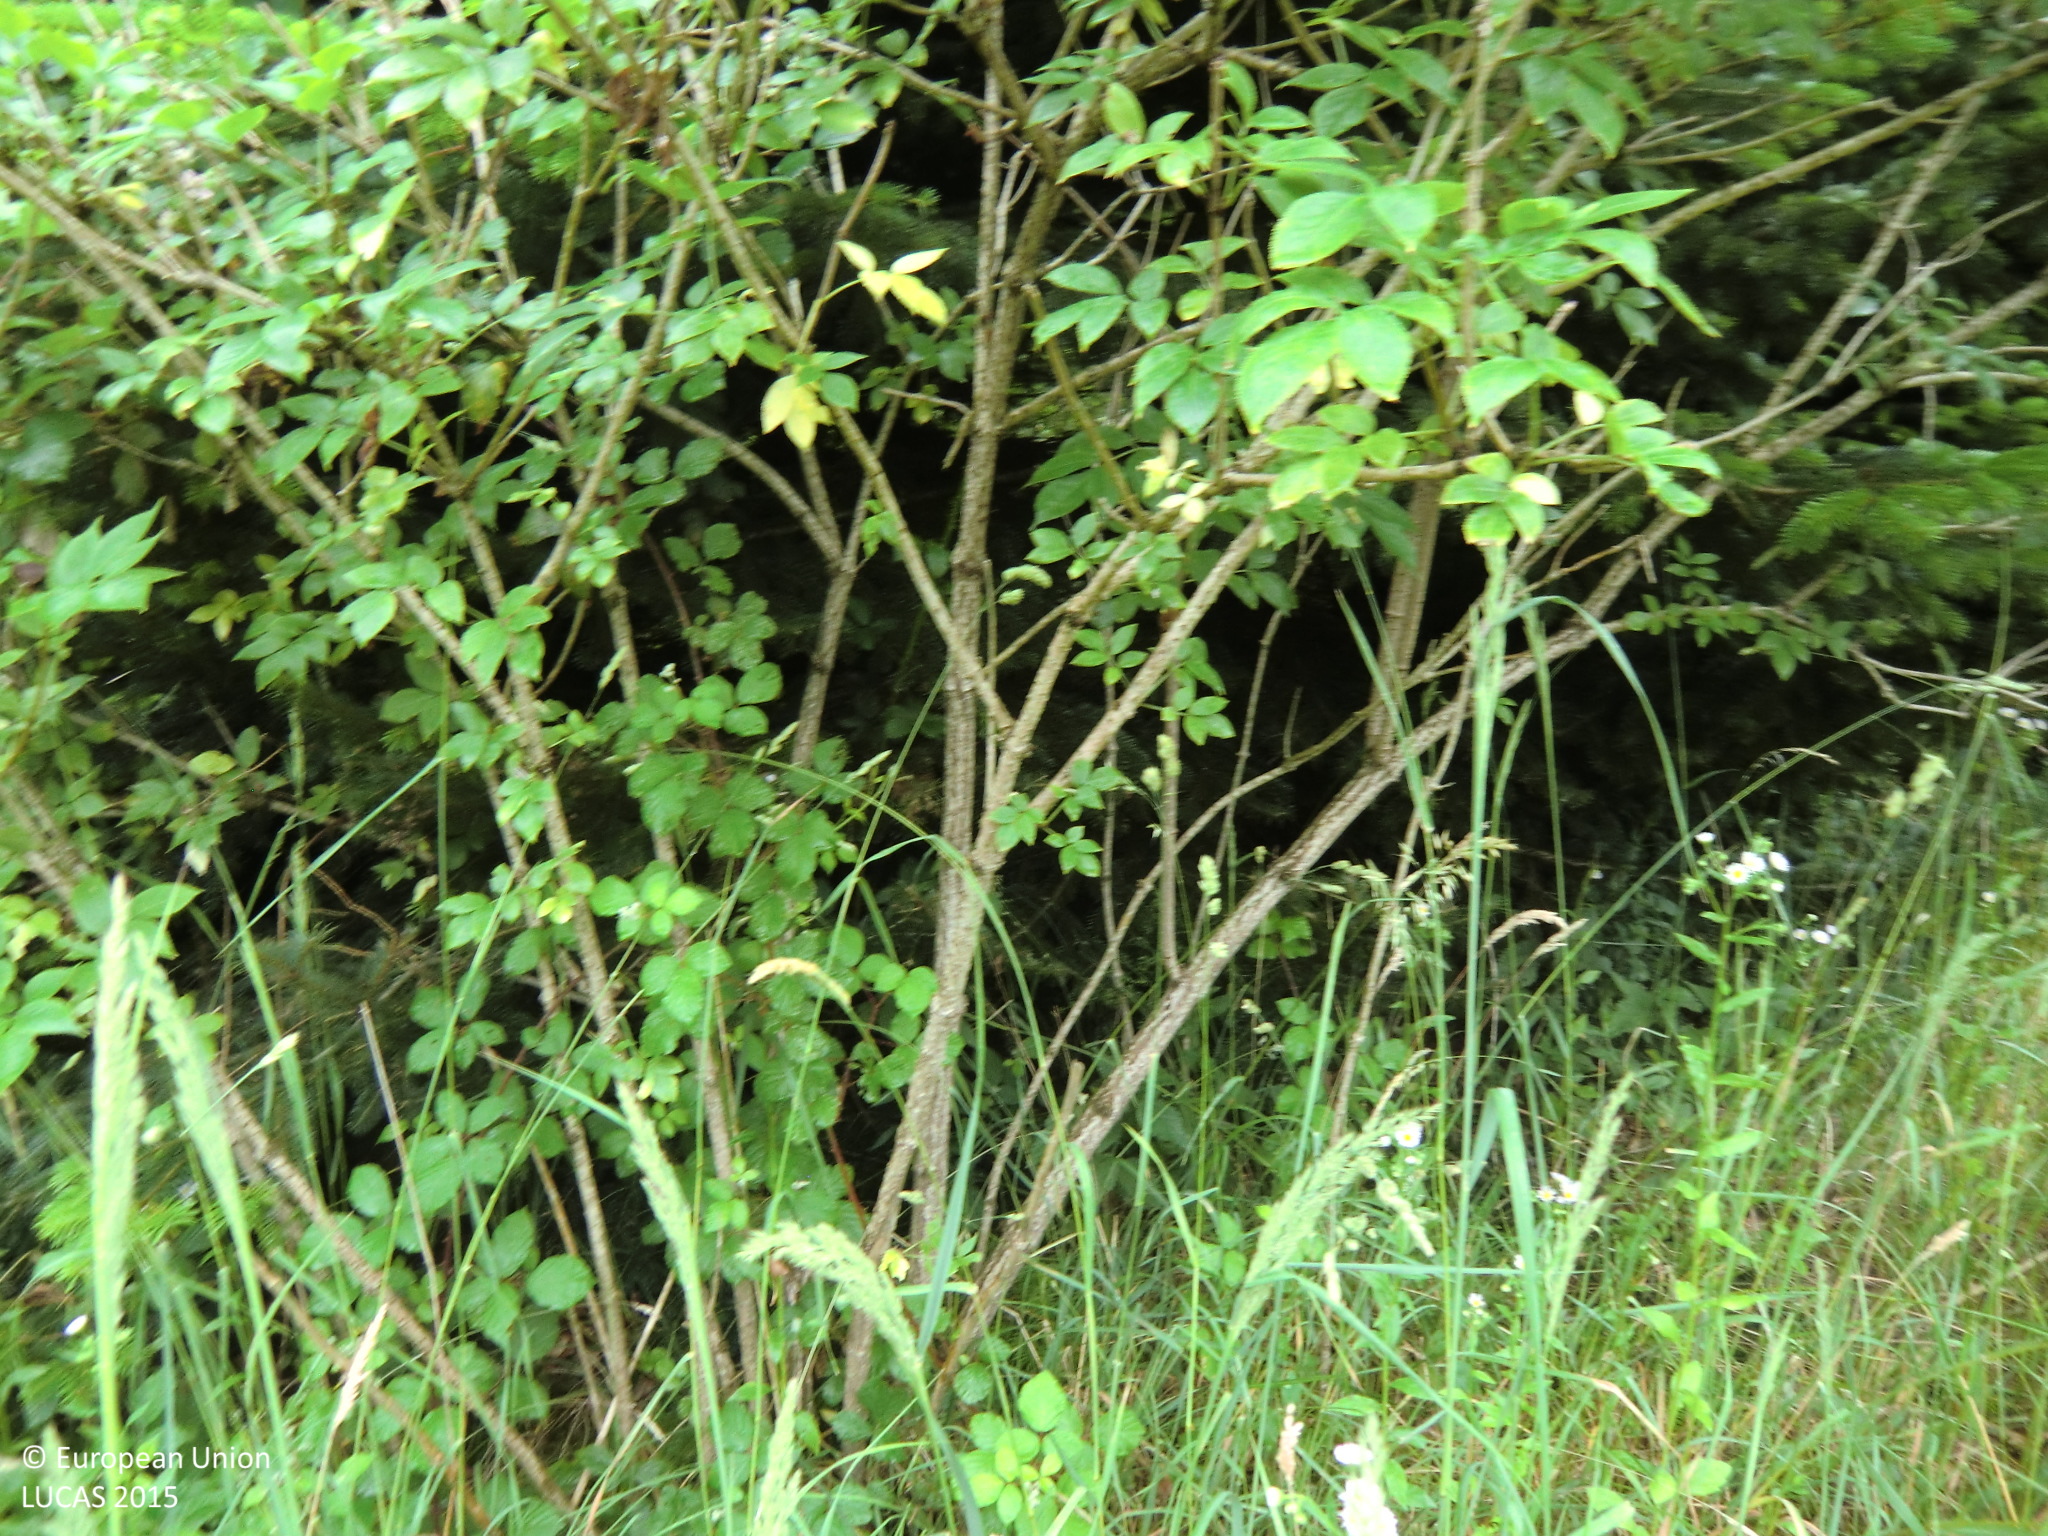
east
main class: Grassland
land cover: Grassland without tree/shrub cover
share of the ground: > 75 %
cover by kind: herbaceous plants 100 %
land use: Agriculture (excluding fallow land and kitchen gardens)
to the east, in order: Grassland without tree/shrub cover; Spruce dominated mixed woodland; Fences; Spruce dominated mixed woodland; Rocks and stones; Spruce dominated mixed woodland; Broadleaved woodland; Fences; Paved roads, cycling and walking lanes; Lines of trees; Grassland with sparse tree/shrub cover; Tracks; Grassland without tree/shrub cover
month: June
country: AT
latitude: 47.1935
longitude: 16.0069
